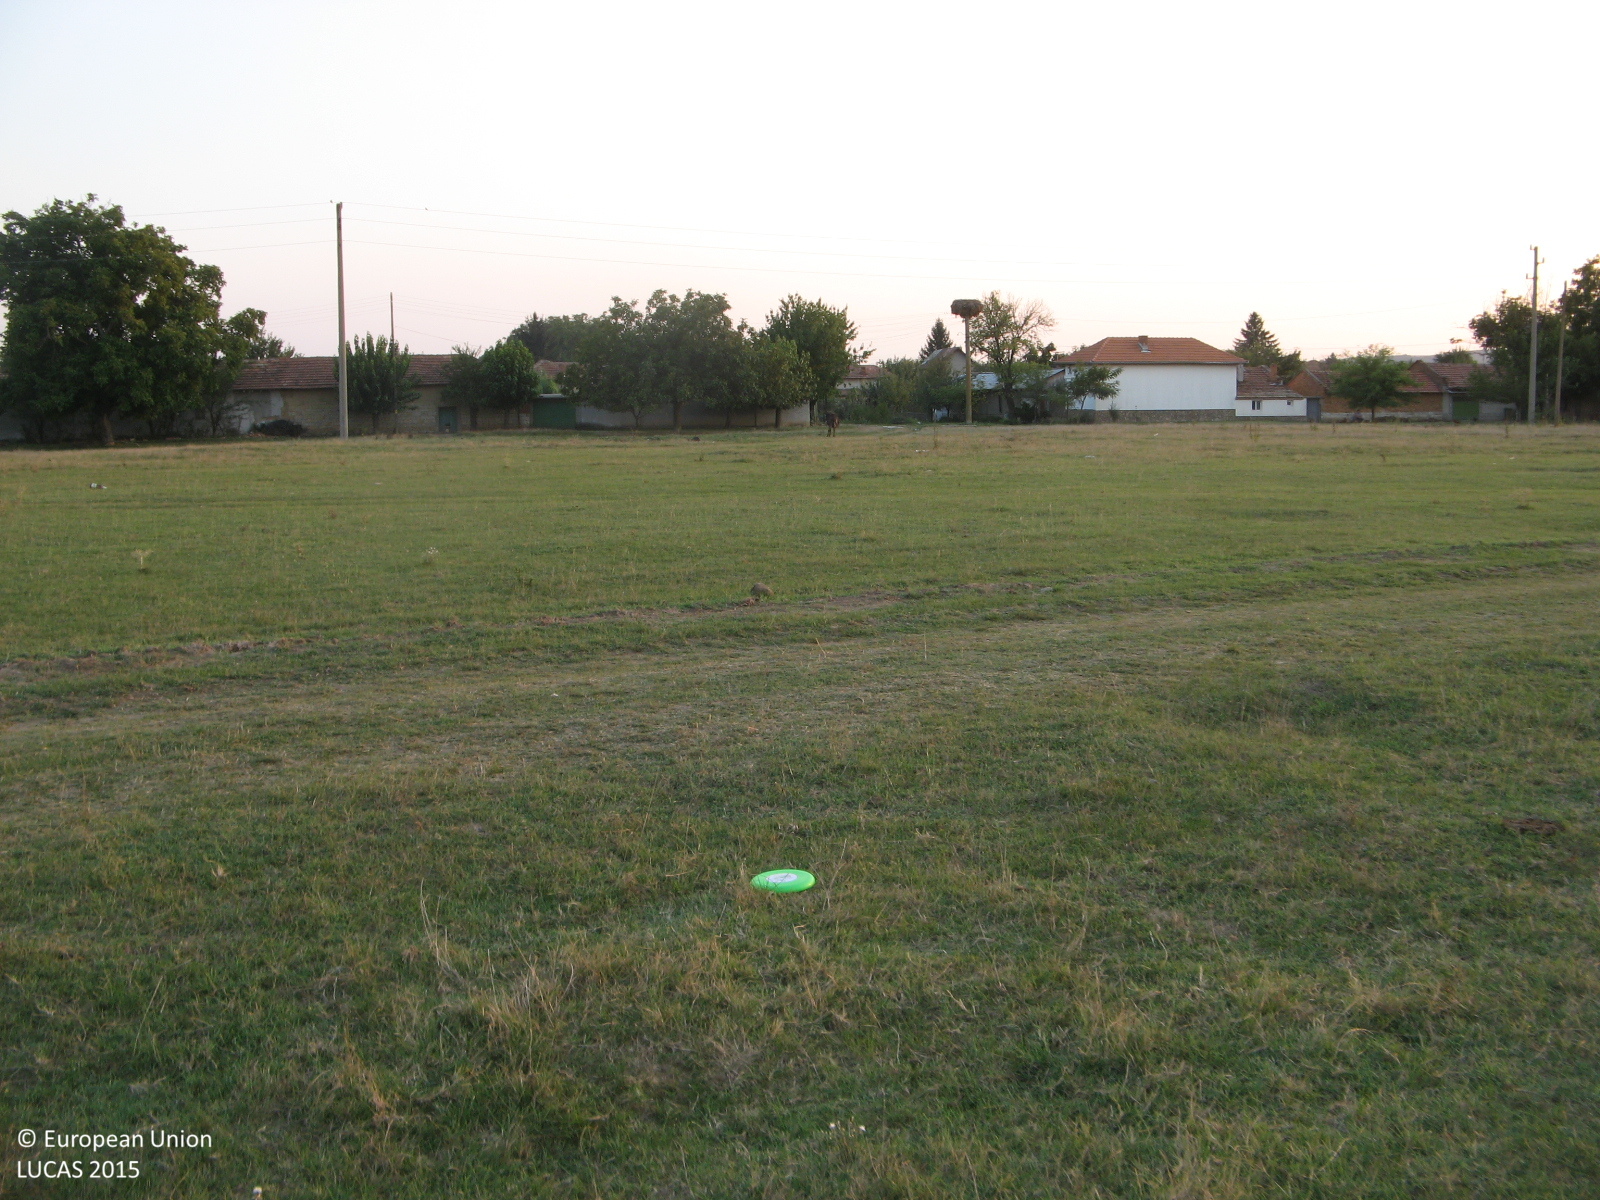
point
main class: Grassland
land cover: Grassland without tree/shrub cover
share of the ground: > 75 %
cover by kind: herbaceous plants 100 %
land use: Agriculture (excluding fallow land and kitchen gardens)
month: September
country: BG
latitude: 43.5334
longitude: 25.6900
